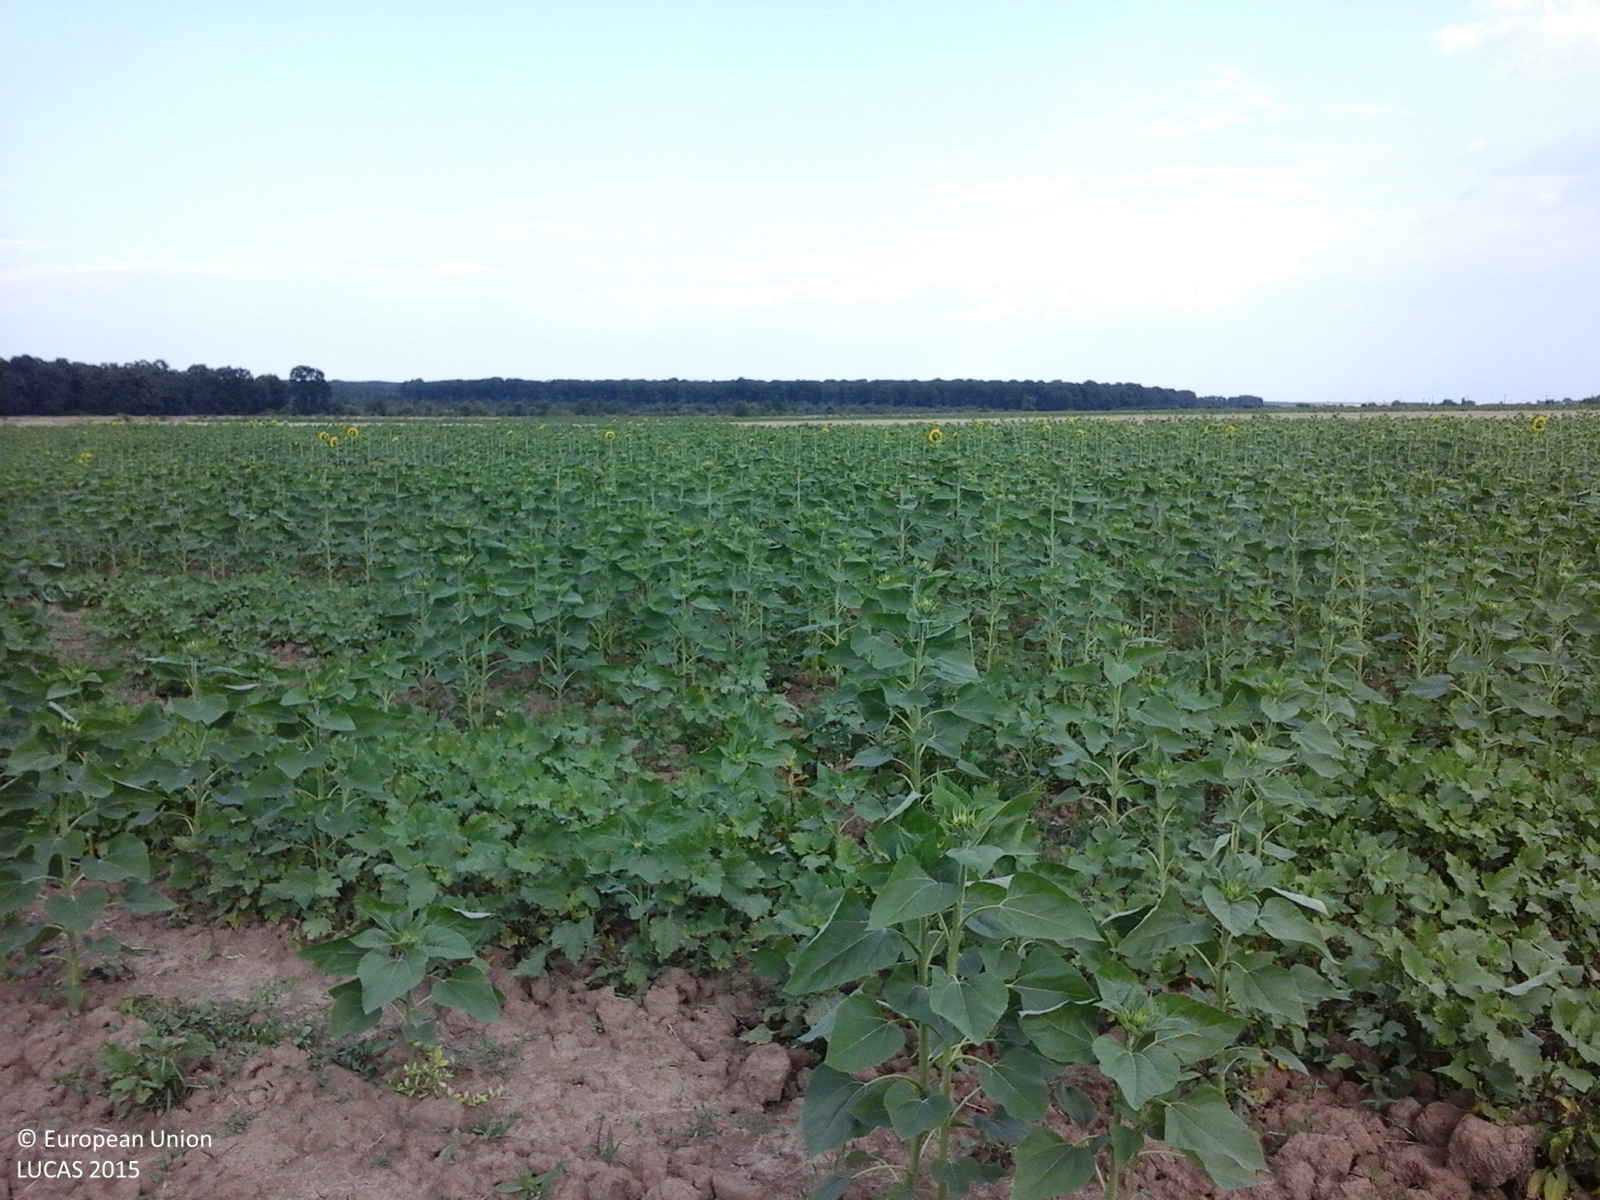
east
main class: Cropland
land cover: Sunflower
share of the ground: > 75 %
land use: Agriculture (excluding fallow land and kitchen gardens)
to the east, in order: Sunflower; Common wheat; Oats; Common wheat; Grassland without tree/shrub cover; Common wheat
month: July
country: RO
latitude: 44.1976
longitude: 24.9291
